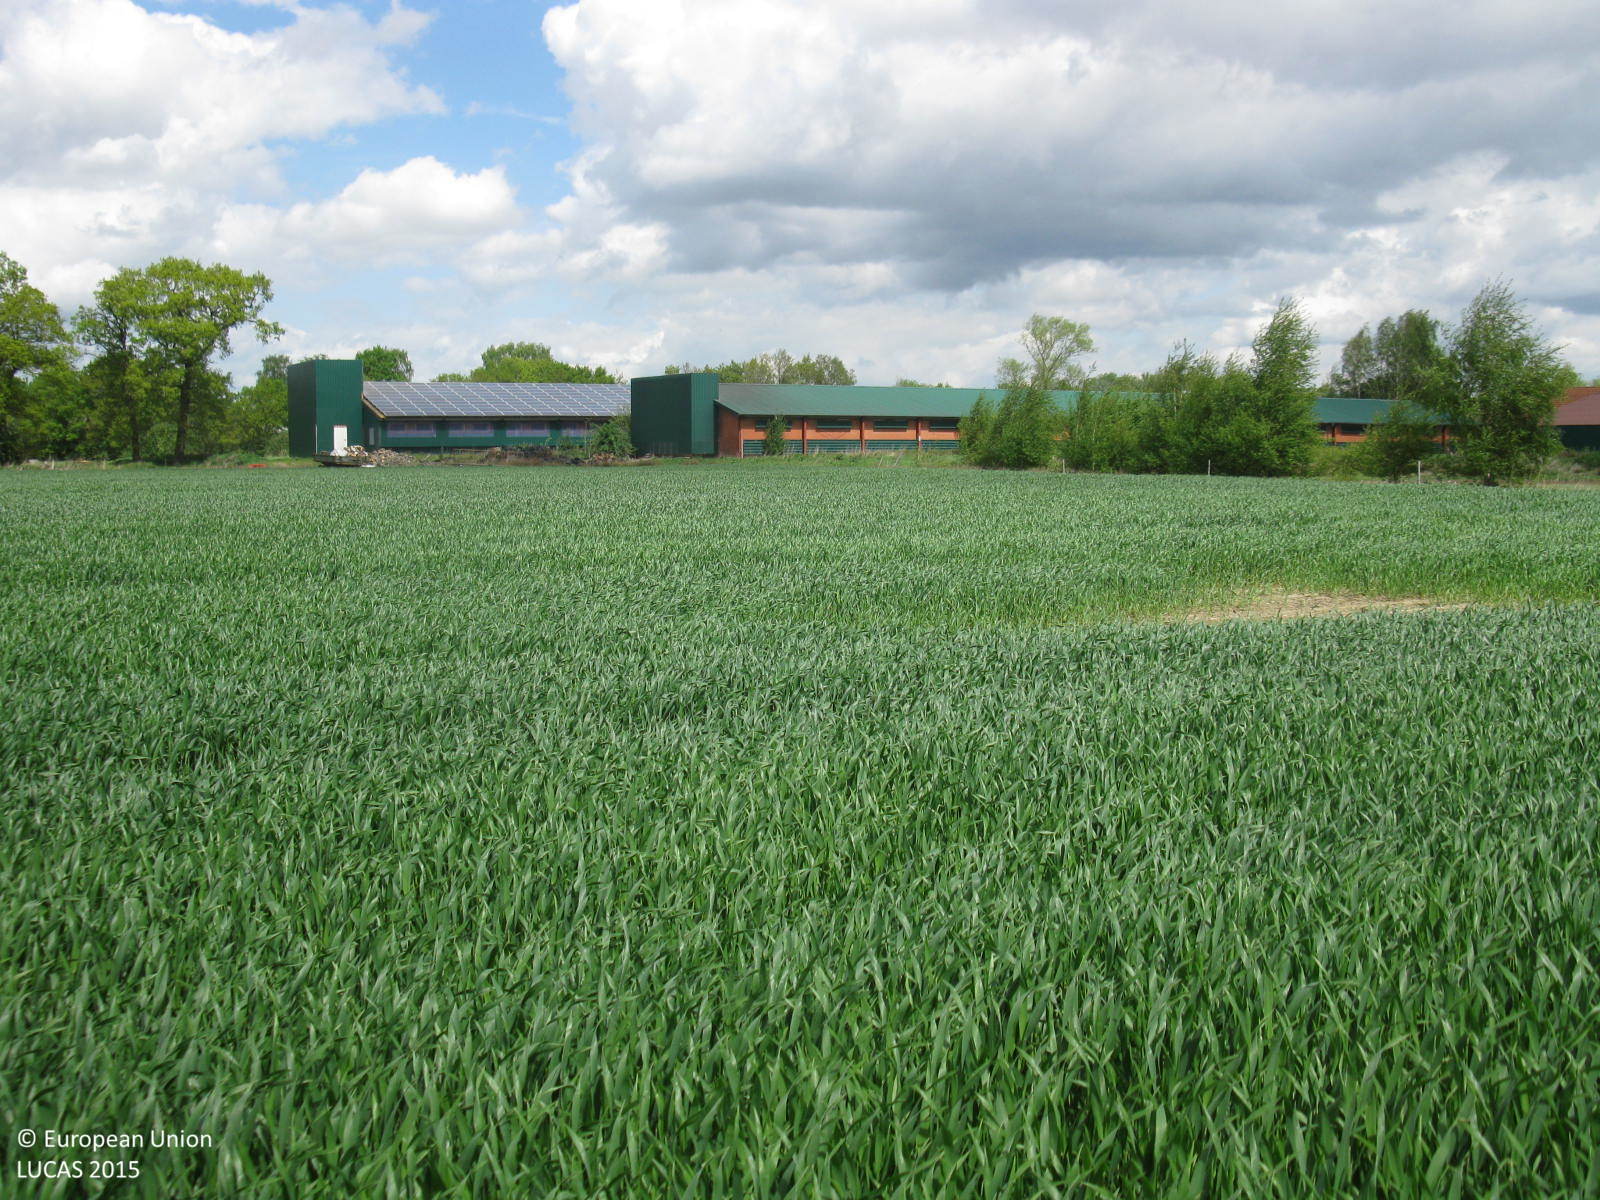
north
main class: Cropland
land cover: Triticale
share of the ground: > 75 %
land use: Agriculture (excluding fallow land and kitchen gardens)
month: May
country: DE
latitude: 52.9763
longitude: 7.3049
